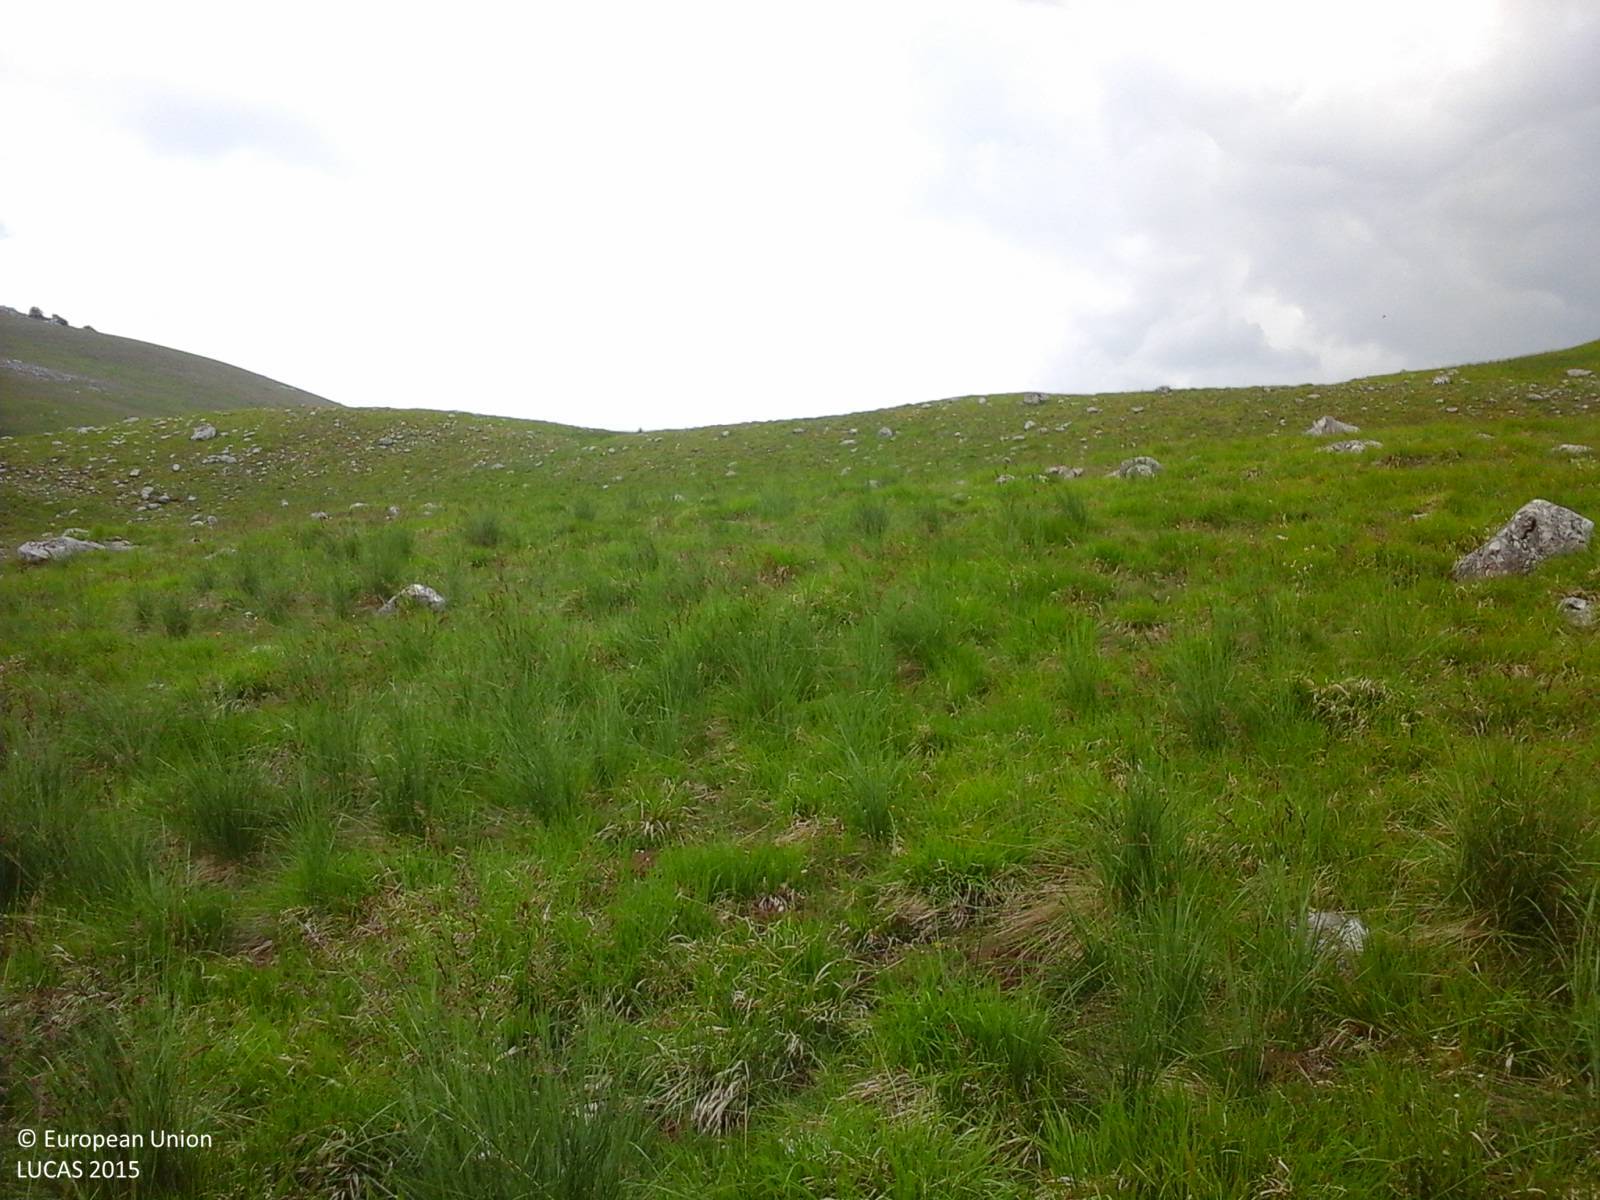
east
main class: Grassland
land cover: Grassland without tree/shrub cover
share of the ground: > 75 %
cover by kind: herbaceous plants 95 %, unconsolidated bare surface 5 %
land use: Agriculture (excluding fallow land and kitchen gardens)
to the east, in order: Grassland without tree/shrub cover
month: June
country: IT
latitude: 41.8526
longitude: 13.9732
